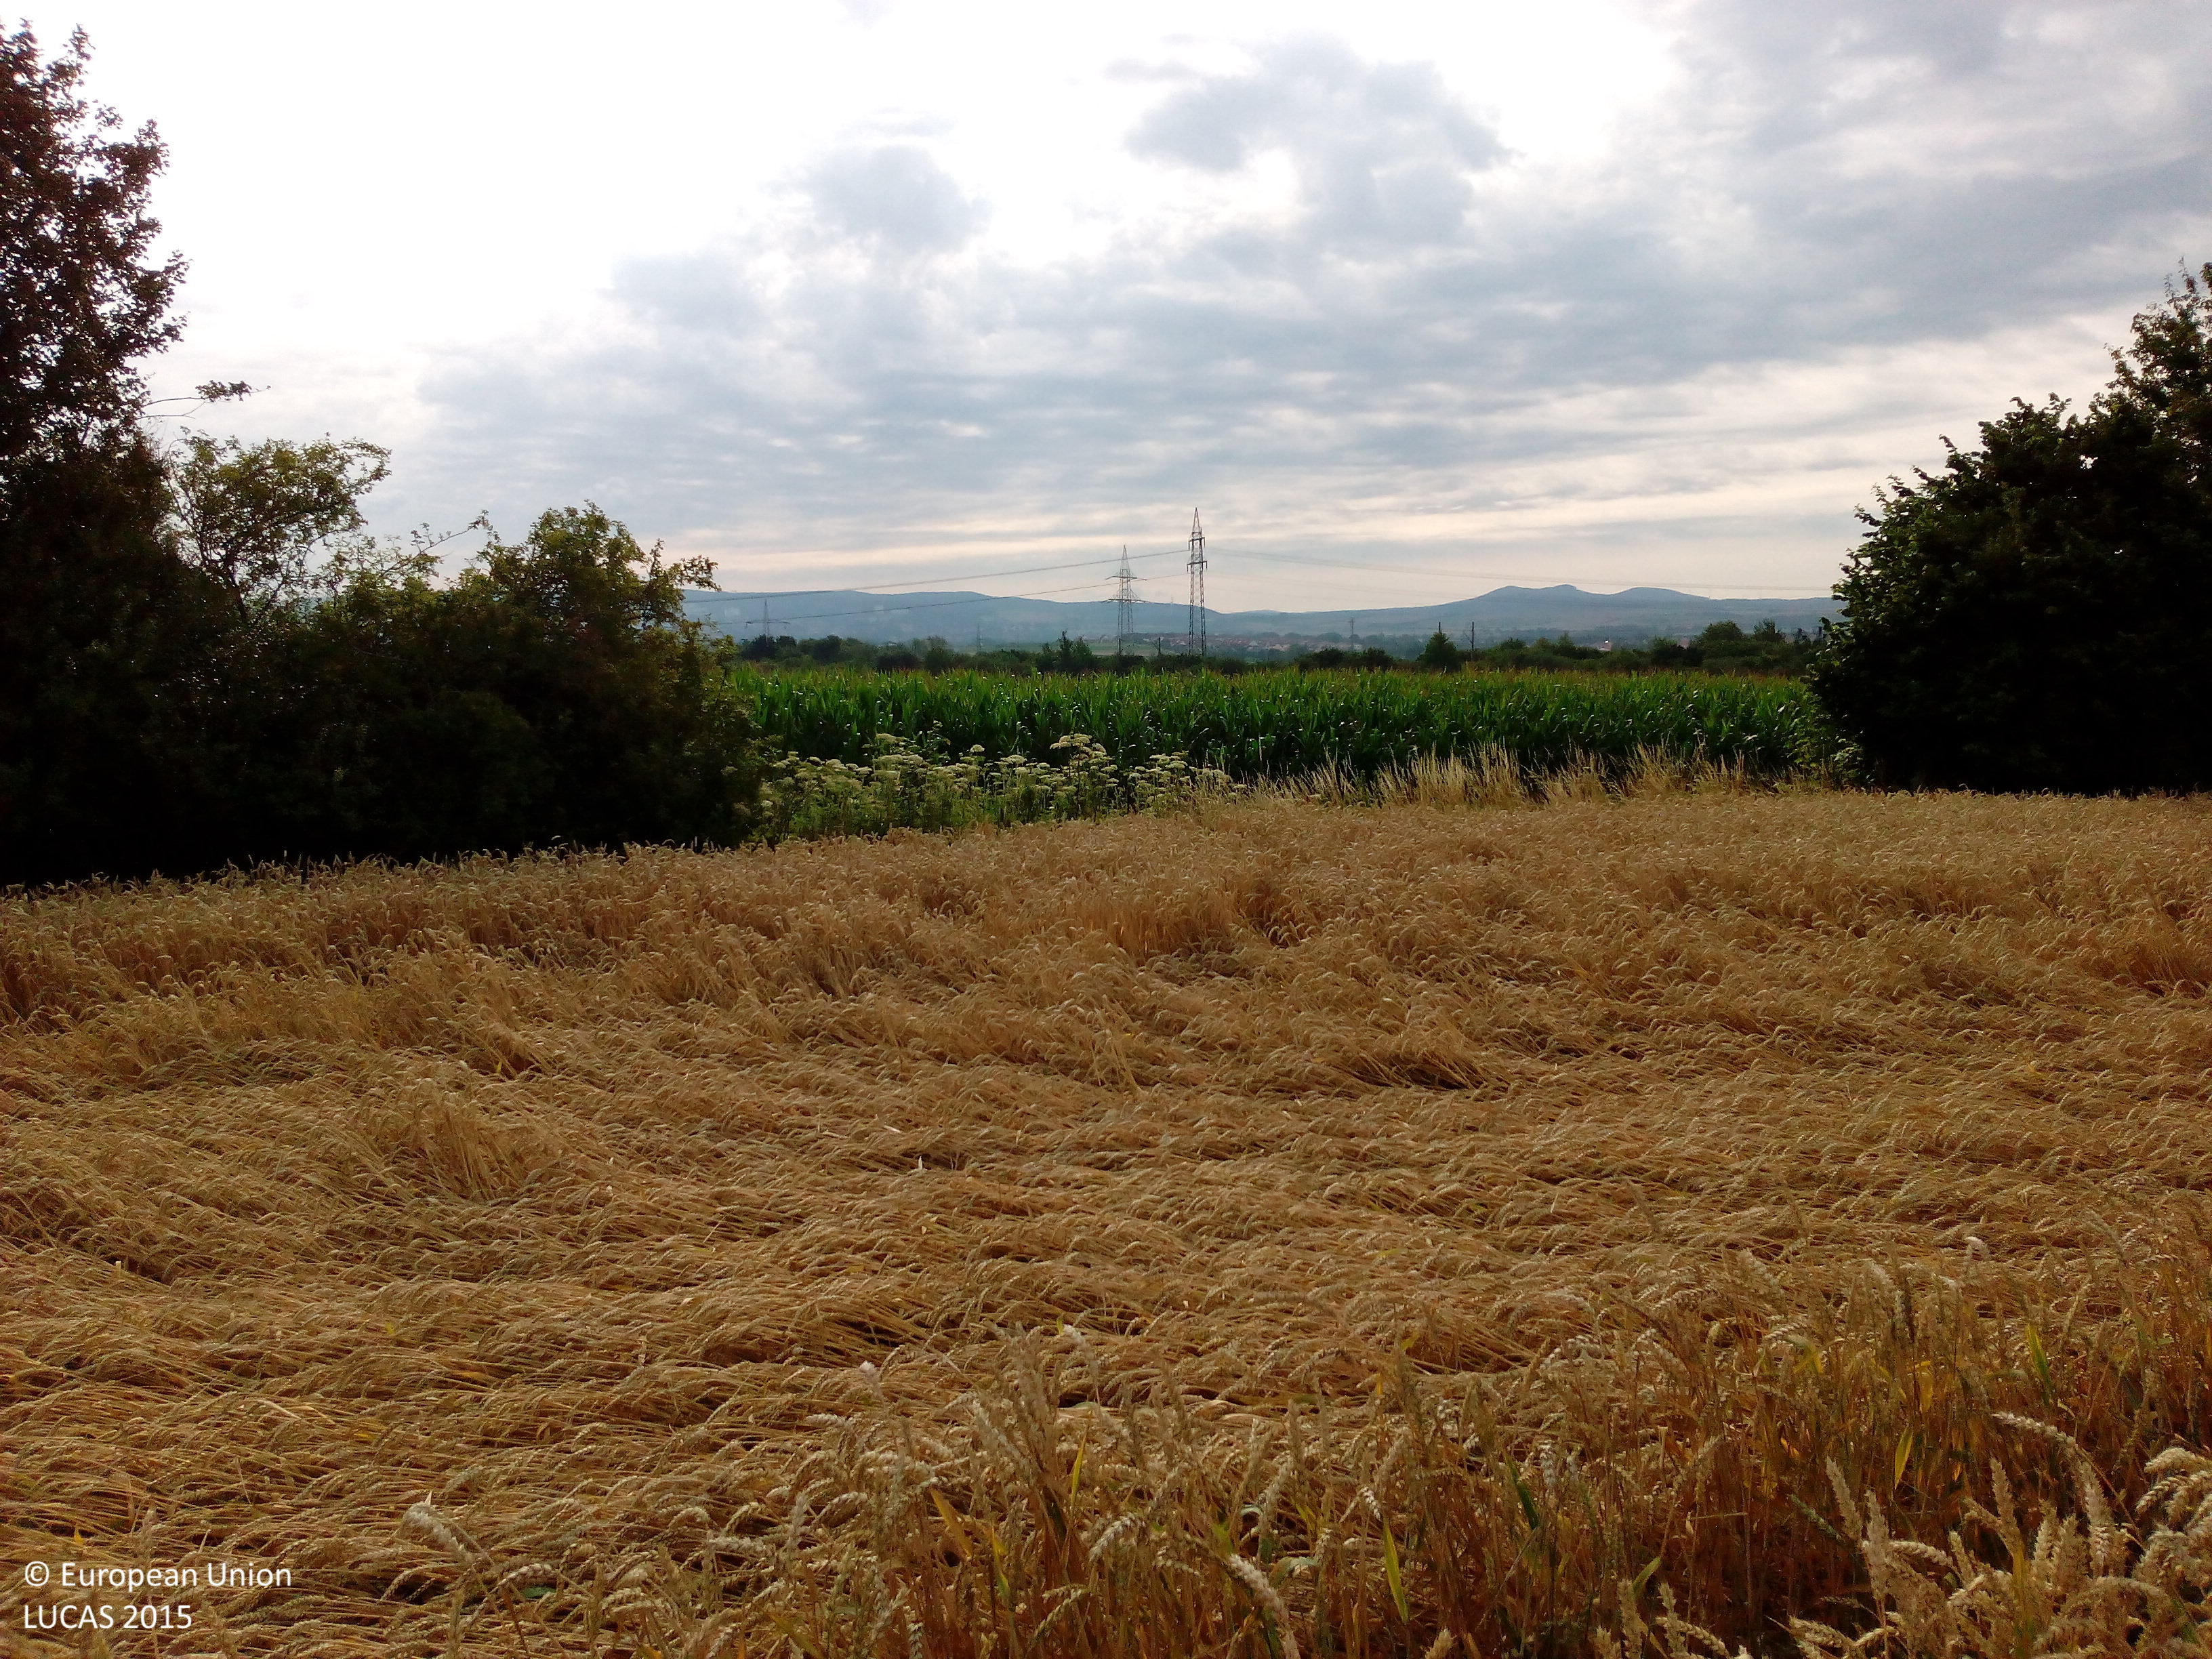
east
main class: Cropland
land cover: Common wheat
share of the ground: > 75 %
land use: Agriculture (excluding fallow land and kitchen gardens)
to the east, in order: Common wheat; Abandoned hedges; Grass margins; Paved roads, cycling and walking lanes; Grass margins; Maize
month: July
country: DE
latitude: 51.5146
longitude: 9.8704
